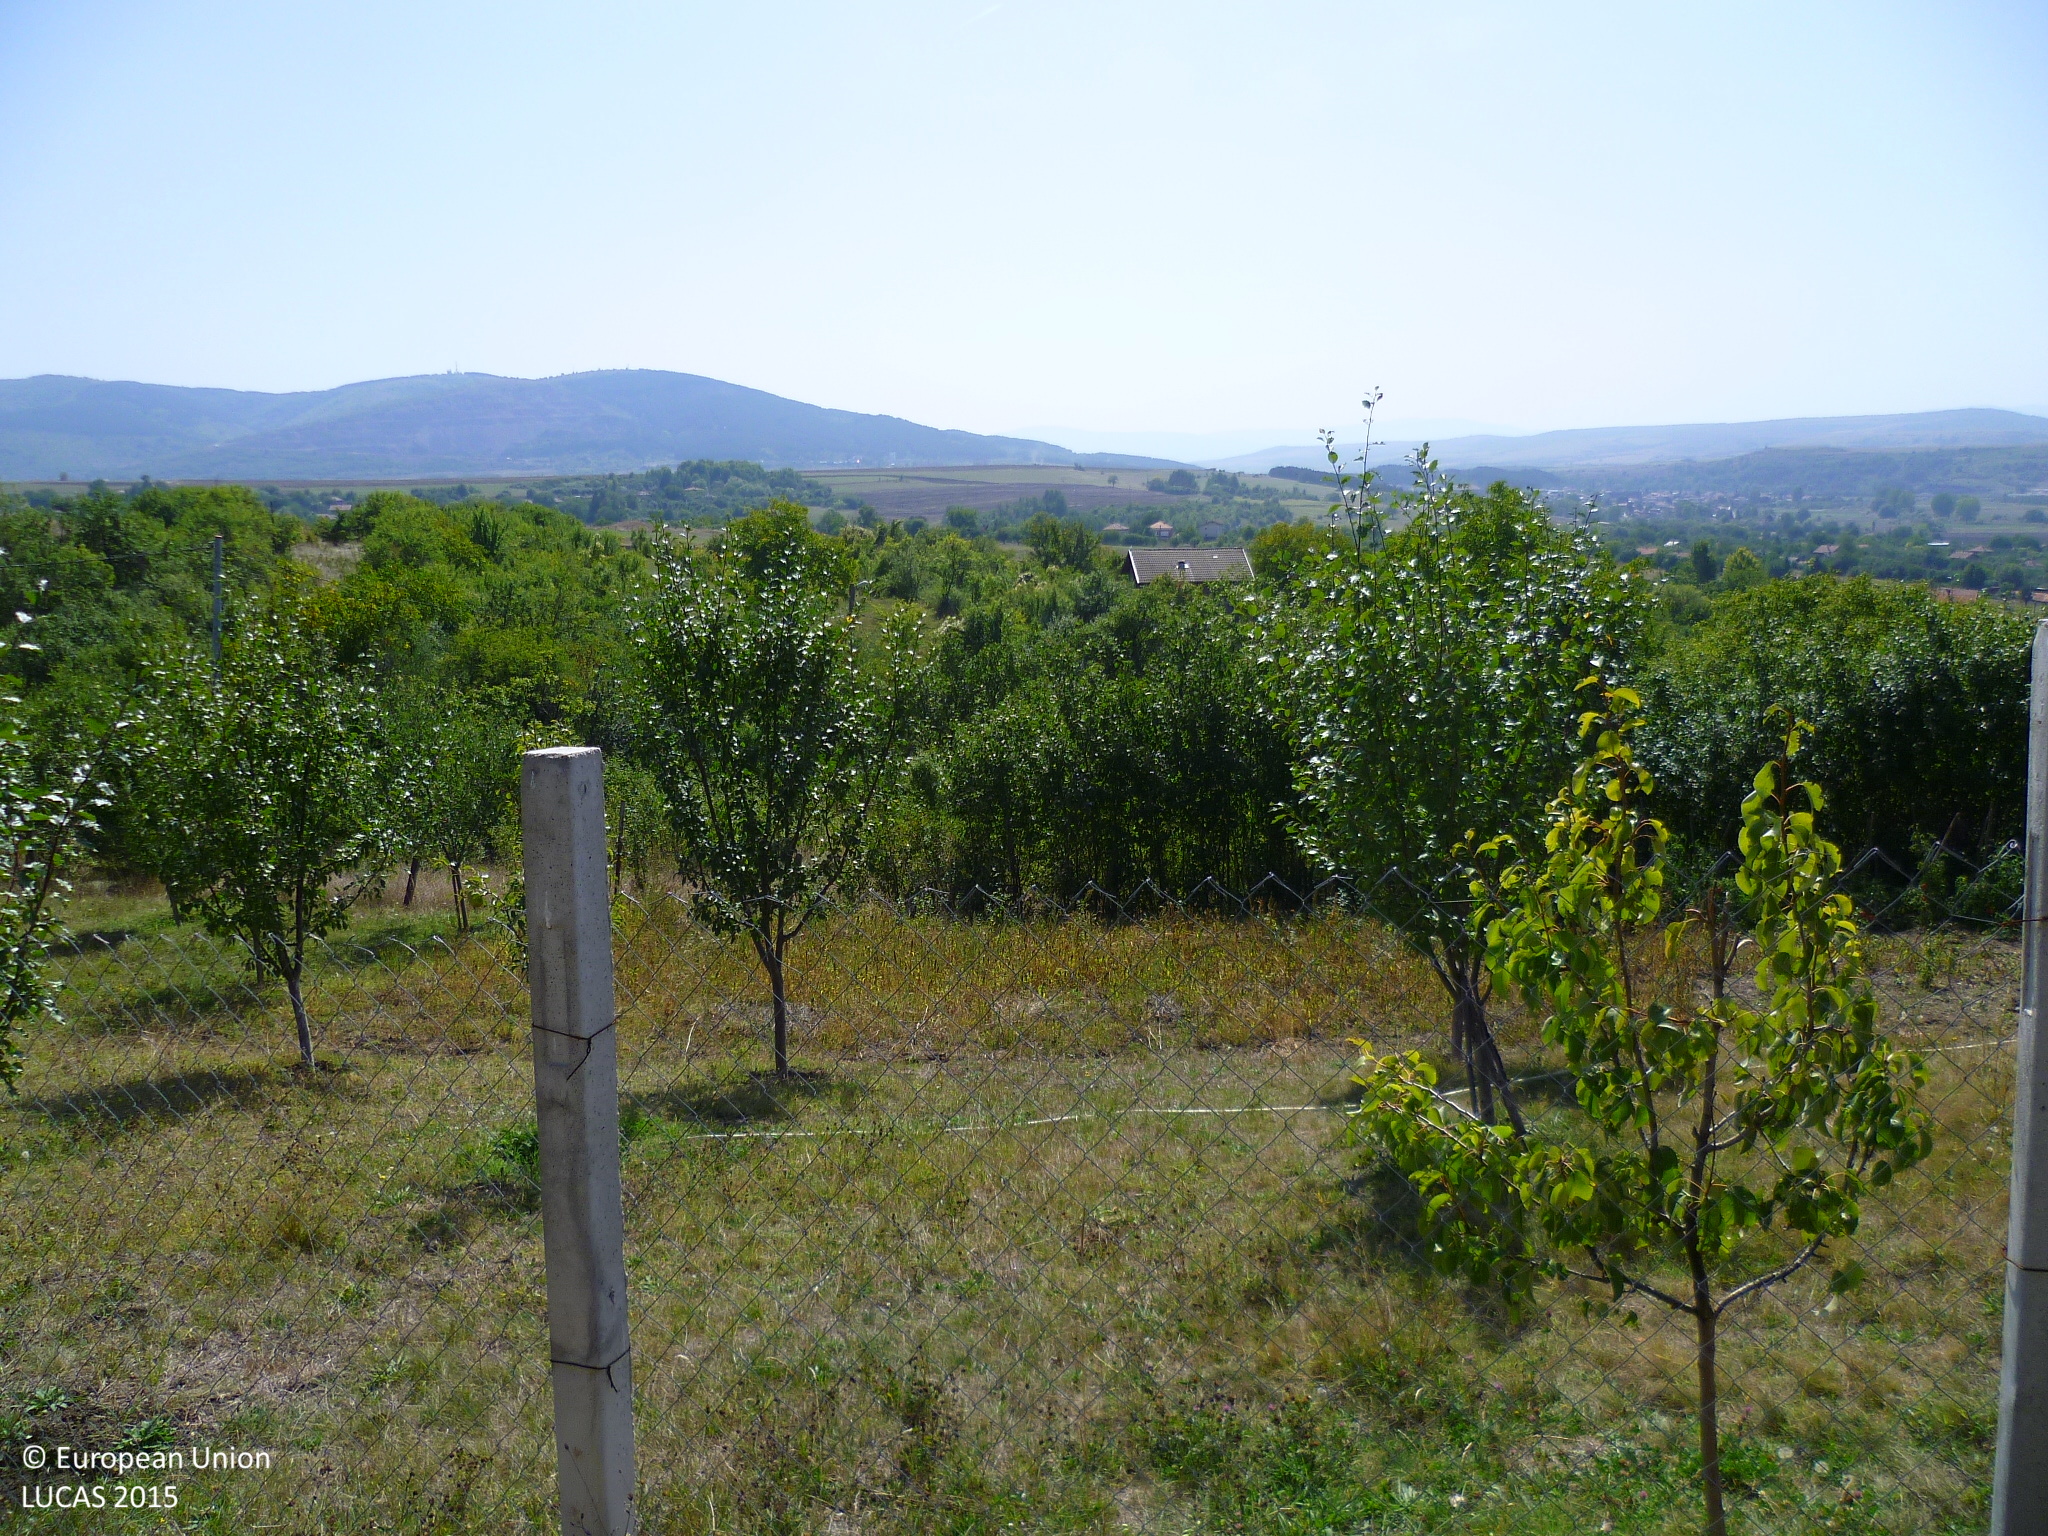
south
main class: Cropland
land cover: Apple fruit
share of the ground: 50 - 75 %
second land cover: Spontaneously vegetated surfaces
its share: 50 - 75 %
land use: Kitchen garden
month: September
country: BG
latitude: 42.6206
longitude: 22.9642
